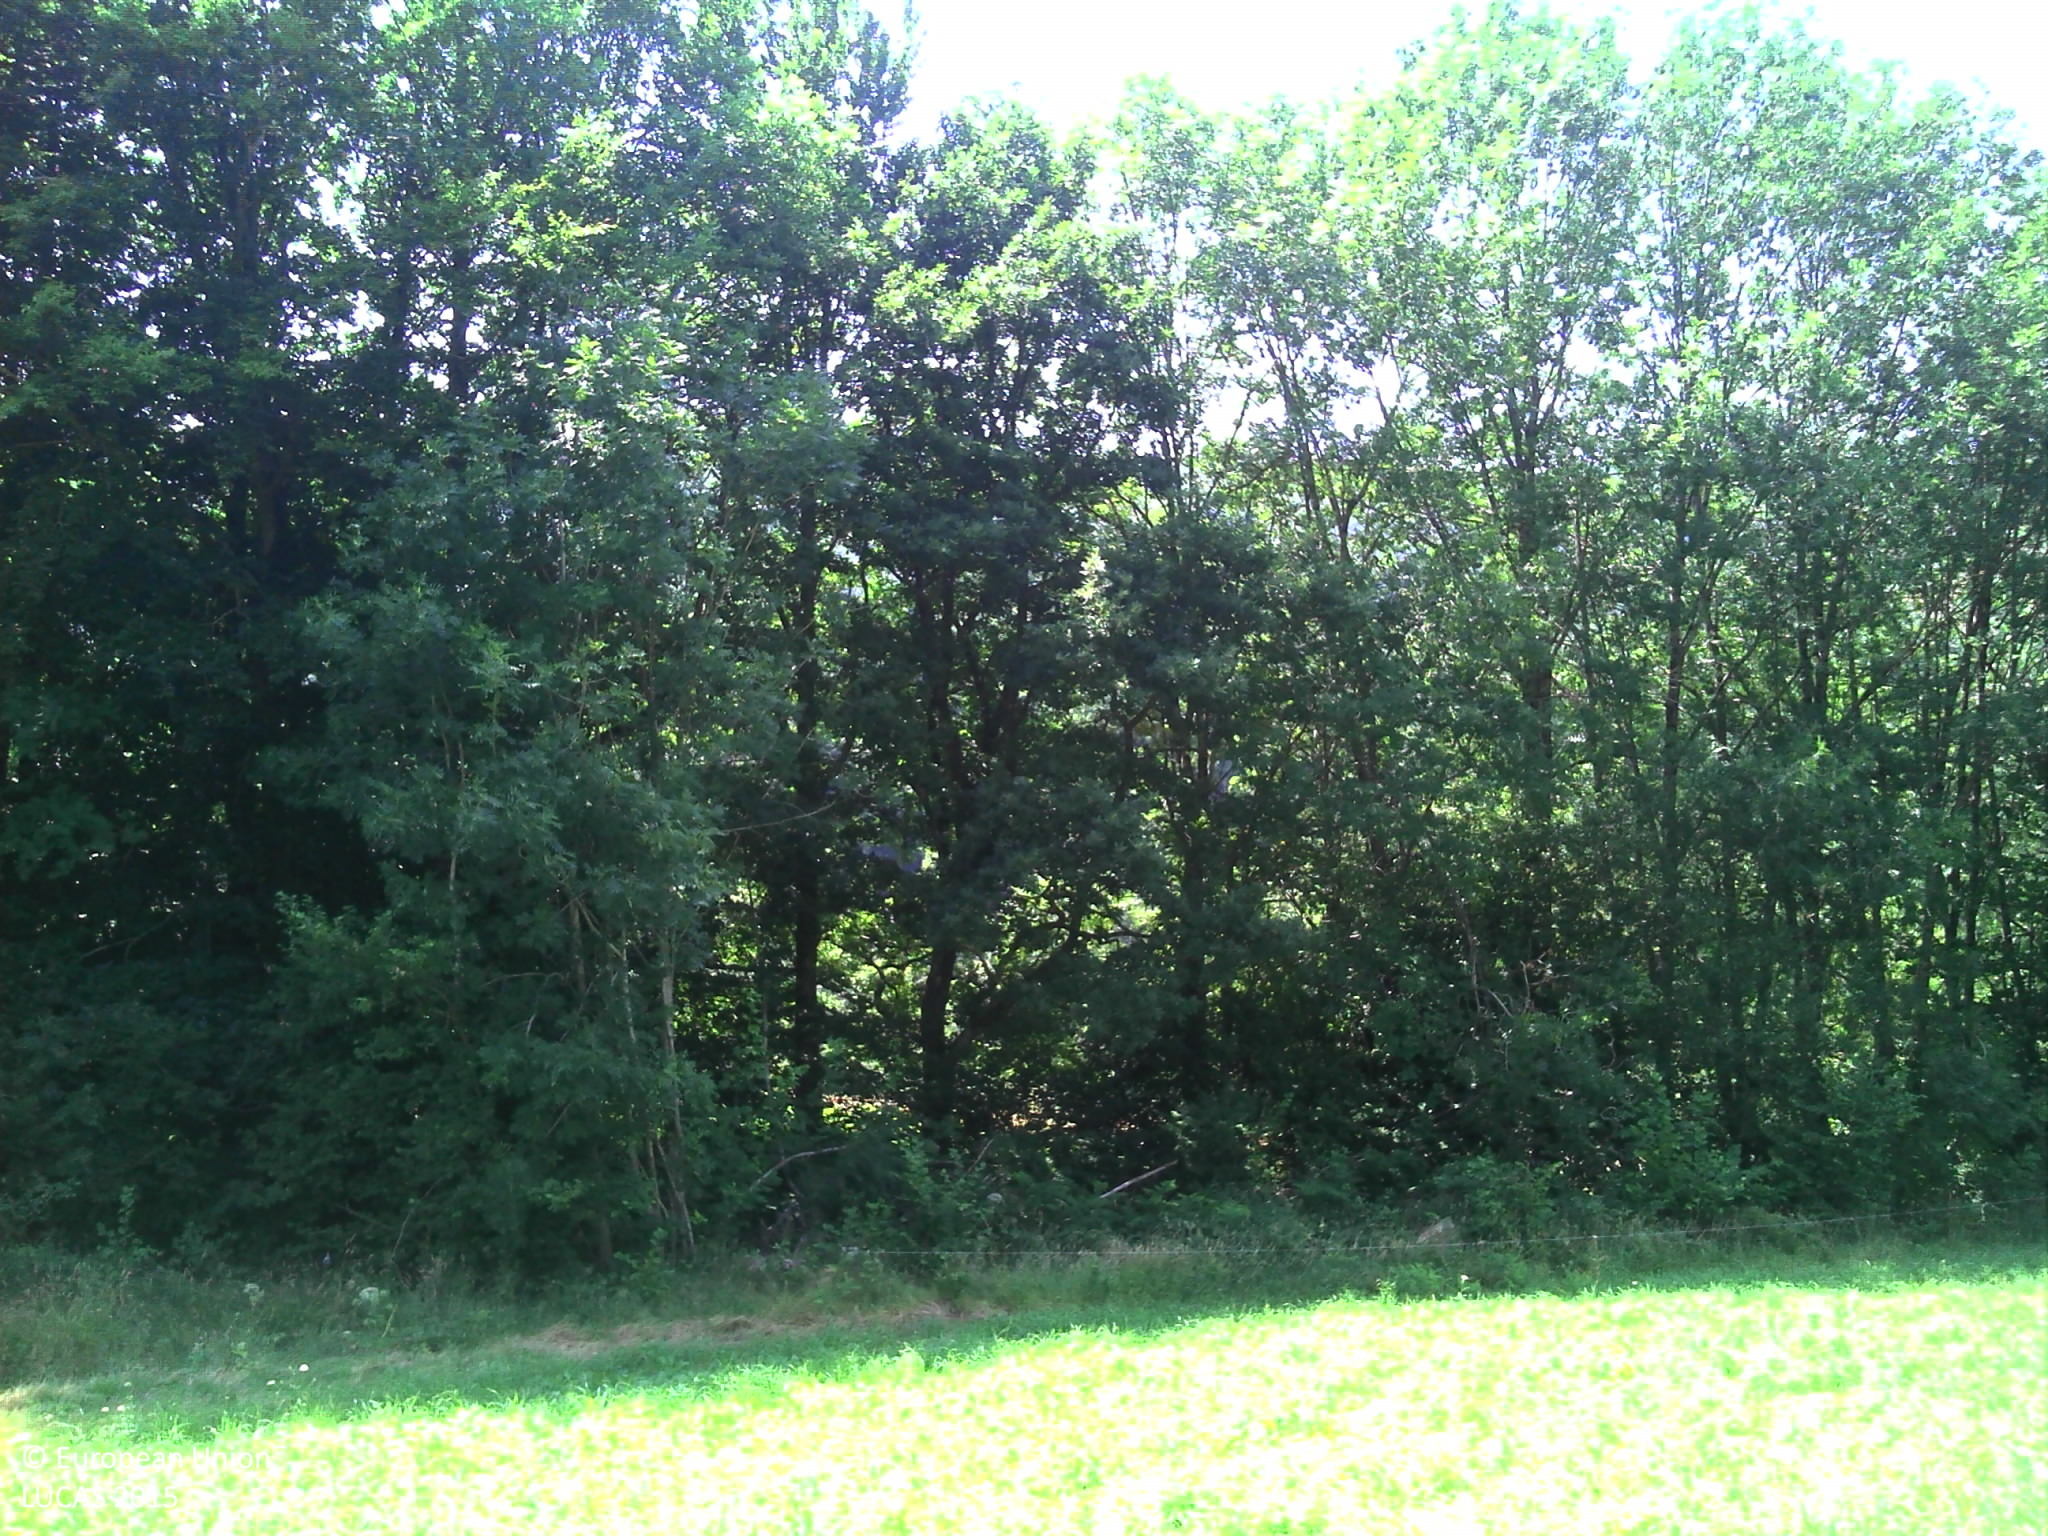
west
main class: Grassland
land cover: Grassland without tree/shrub cover
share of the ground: > 75 %
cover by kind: herbaceous plants 100 %
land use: Agriculture (excluding fallow land and kitchen gardens)
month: July
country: FR
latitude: 43.6554
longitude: 2.6539
